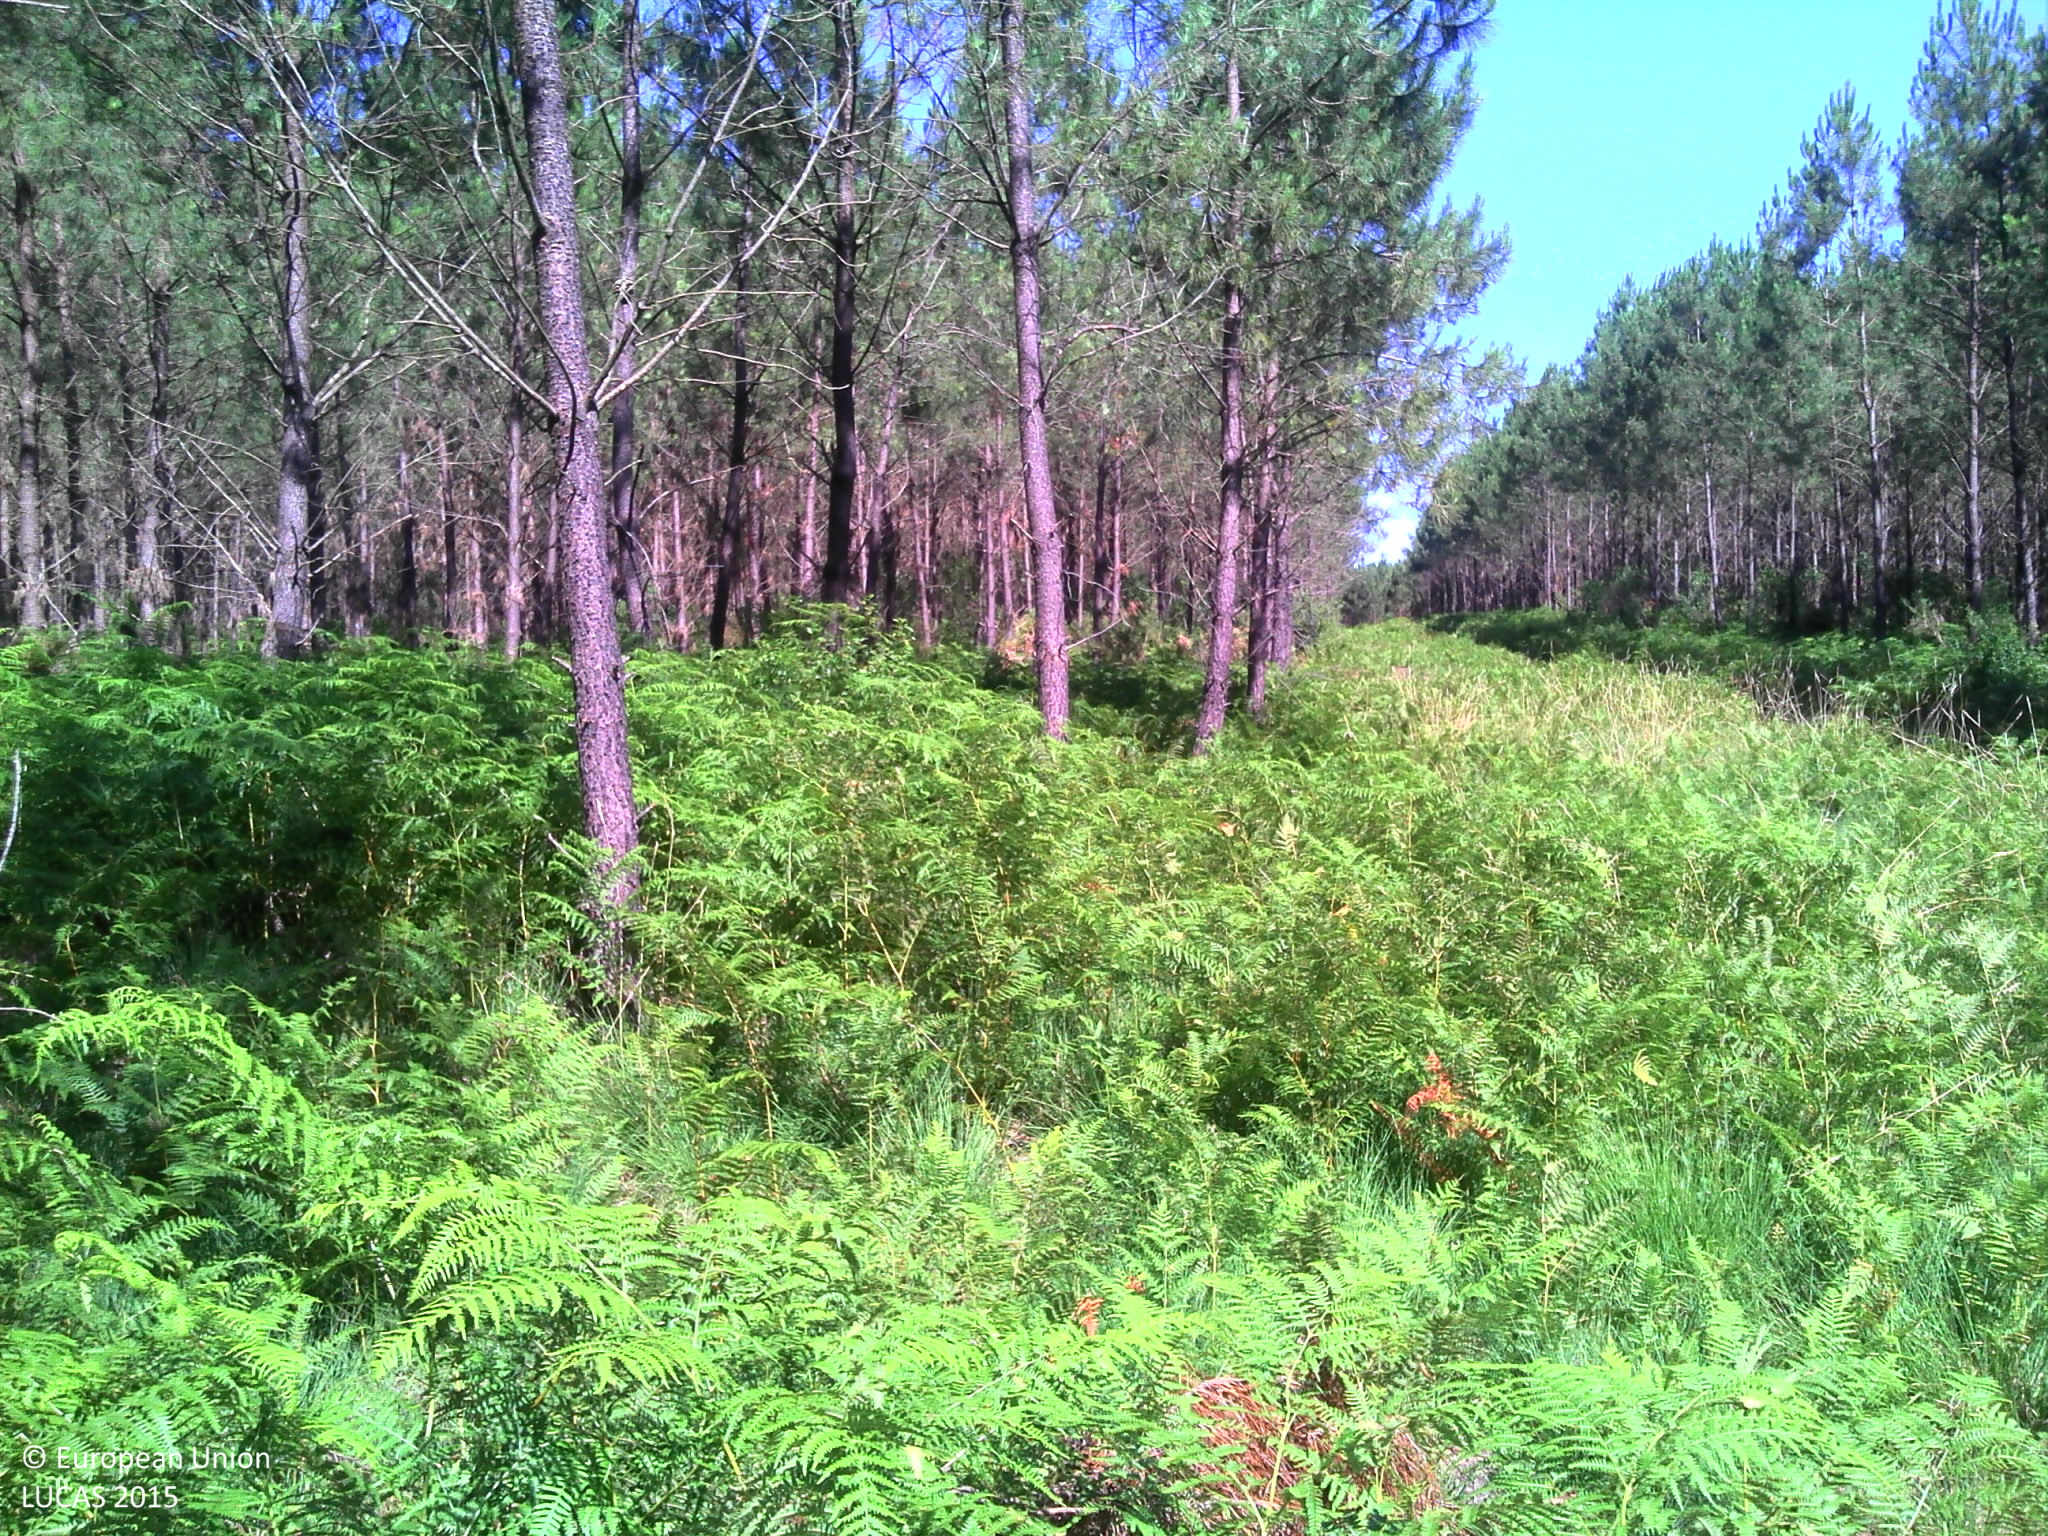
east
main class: Woodland
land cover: Pine dominated coniferous woodland
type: coniferous forest of the mediterranean region
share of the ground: > 75 %
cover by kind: coniferous forest trees 85 %, herbaceous plants 10 %, shrubs 5 %
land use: Forestry
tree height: > 5 m
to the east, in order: Pine dominated coniferous woodland; Spontaneously vegetated surfaces; Ditches and canals; Spontaneously vegetated surfaces; Pine dominated coniferous woodland; Tracks; Pine dominated coniferous woodland
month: July
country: FR
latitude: 43.9956
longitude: -0.5250
